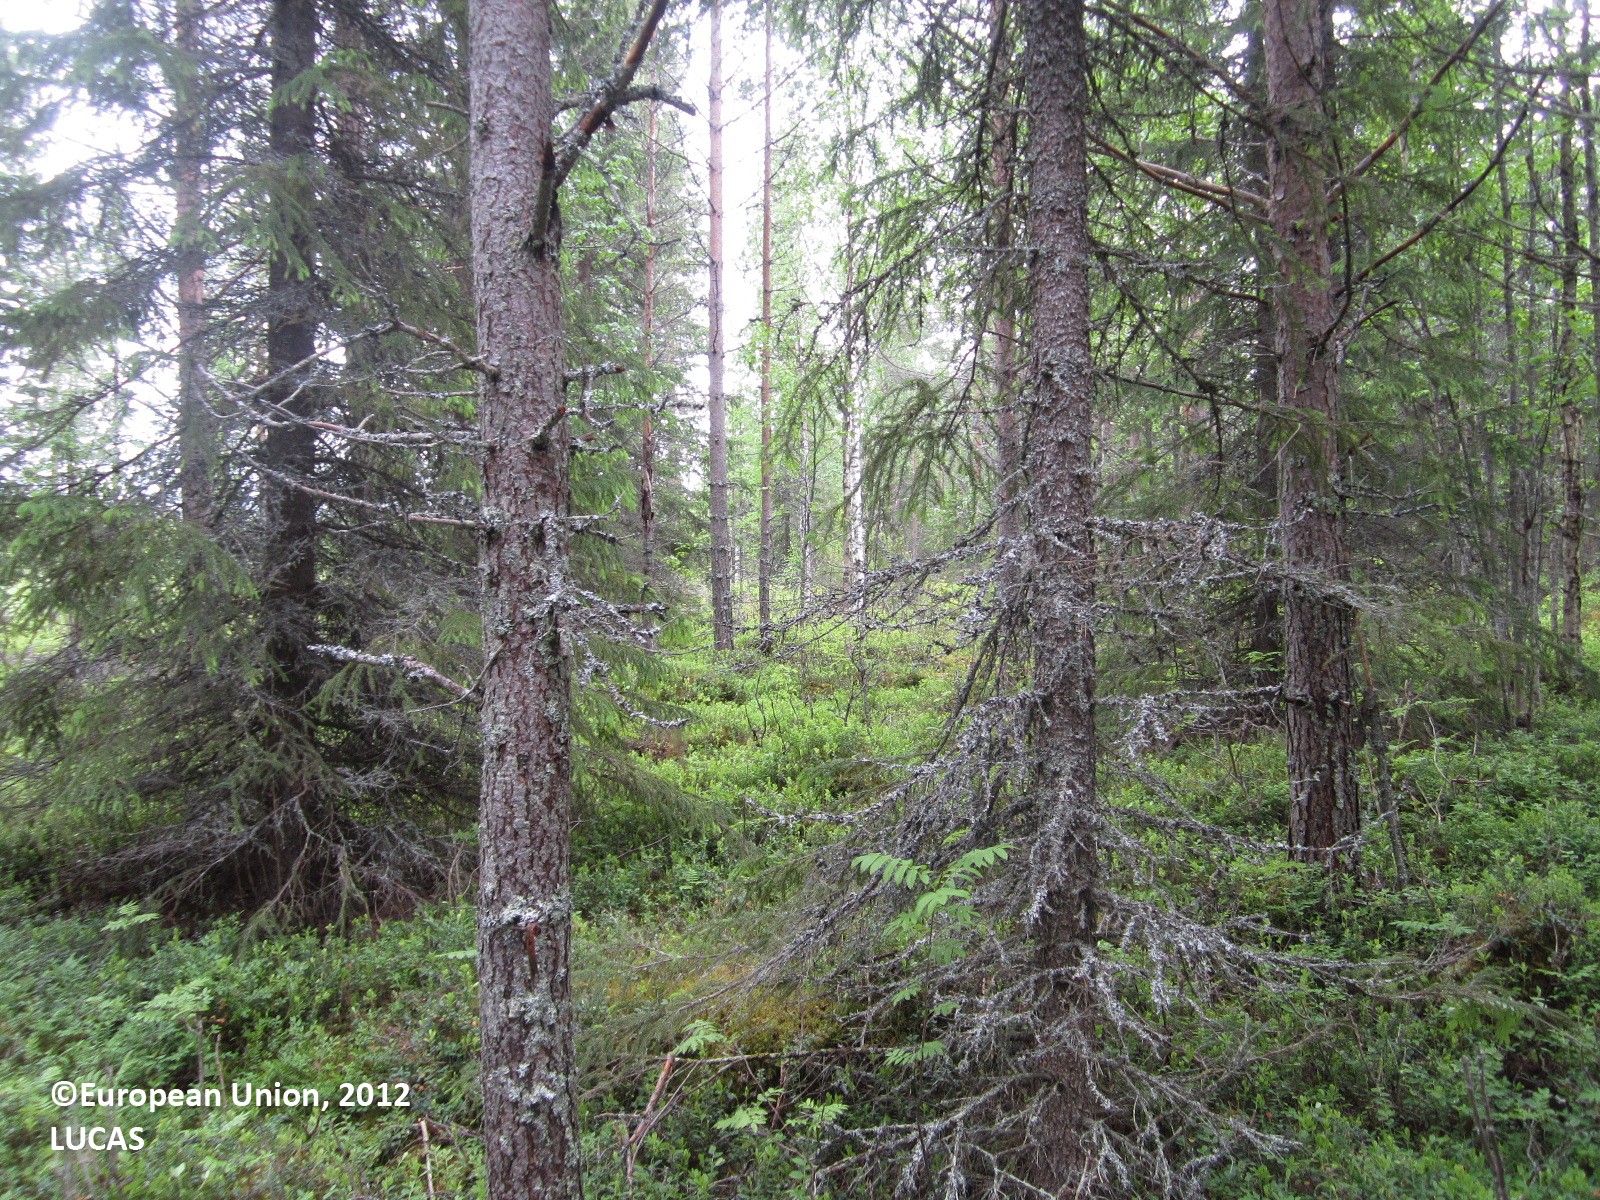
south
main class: Woodland
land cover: Other coniferous woodland
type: boreal forest
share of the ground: > 75 %
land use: Forestry
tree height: > 5 m
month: June
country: FI
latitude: 64.3440
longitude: 29.8327
